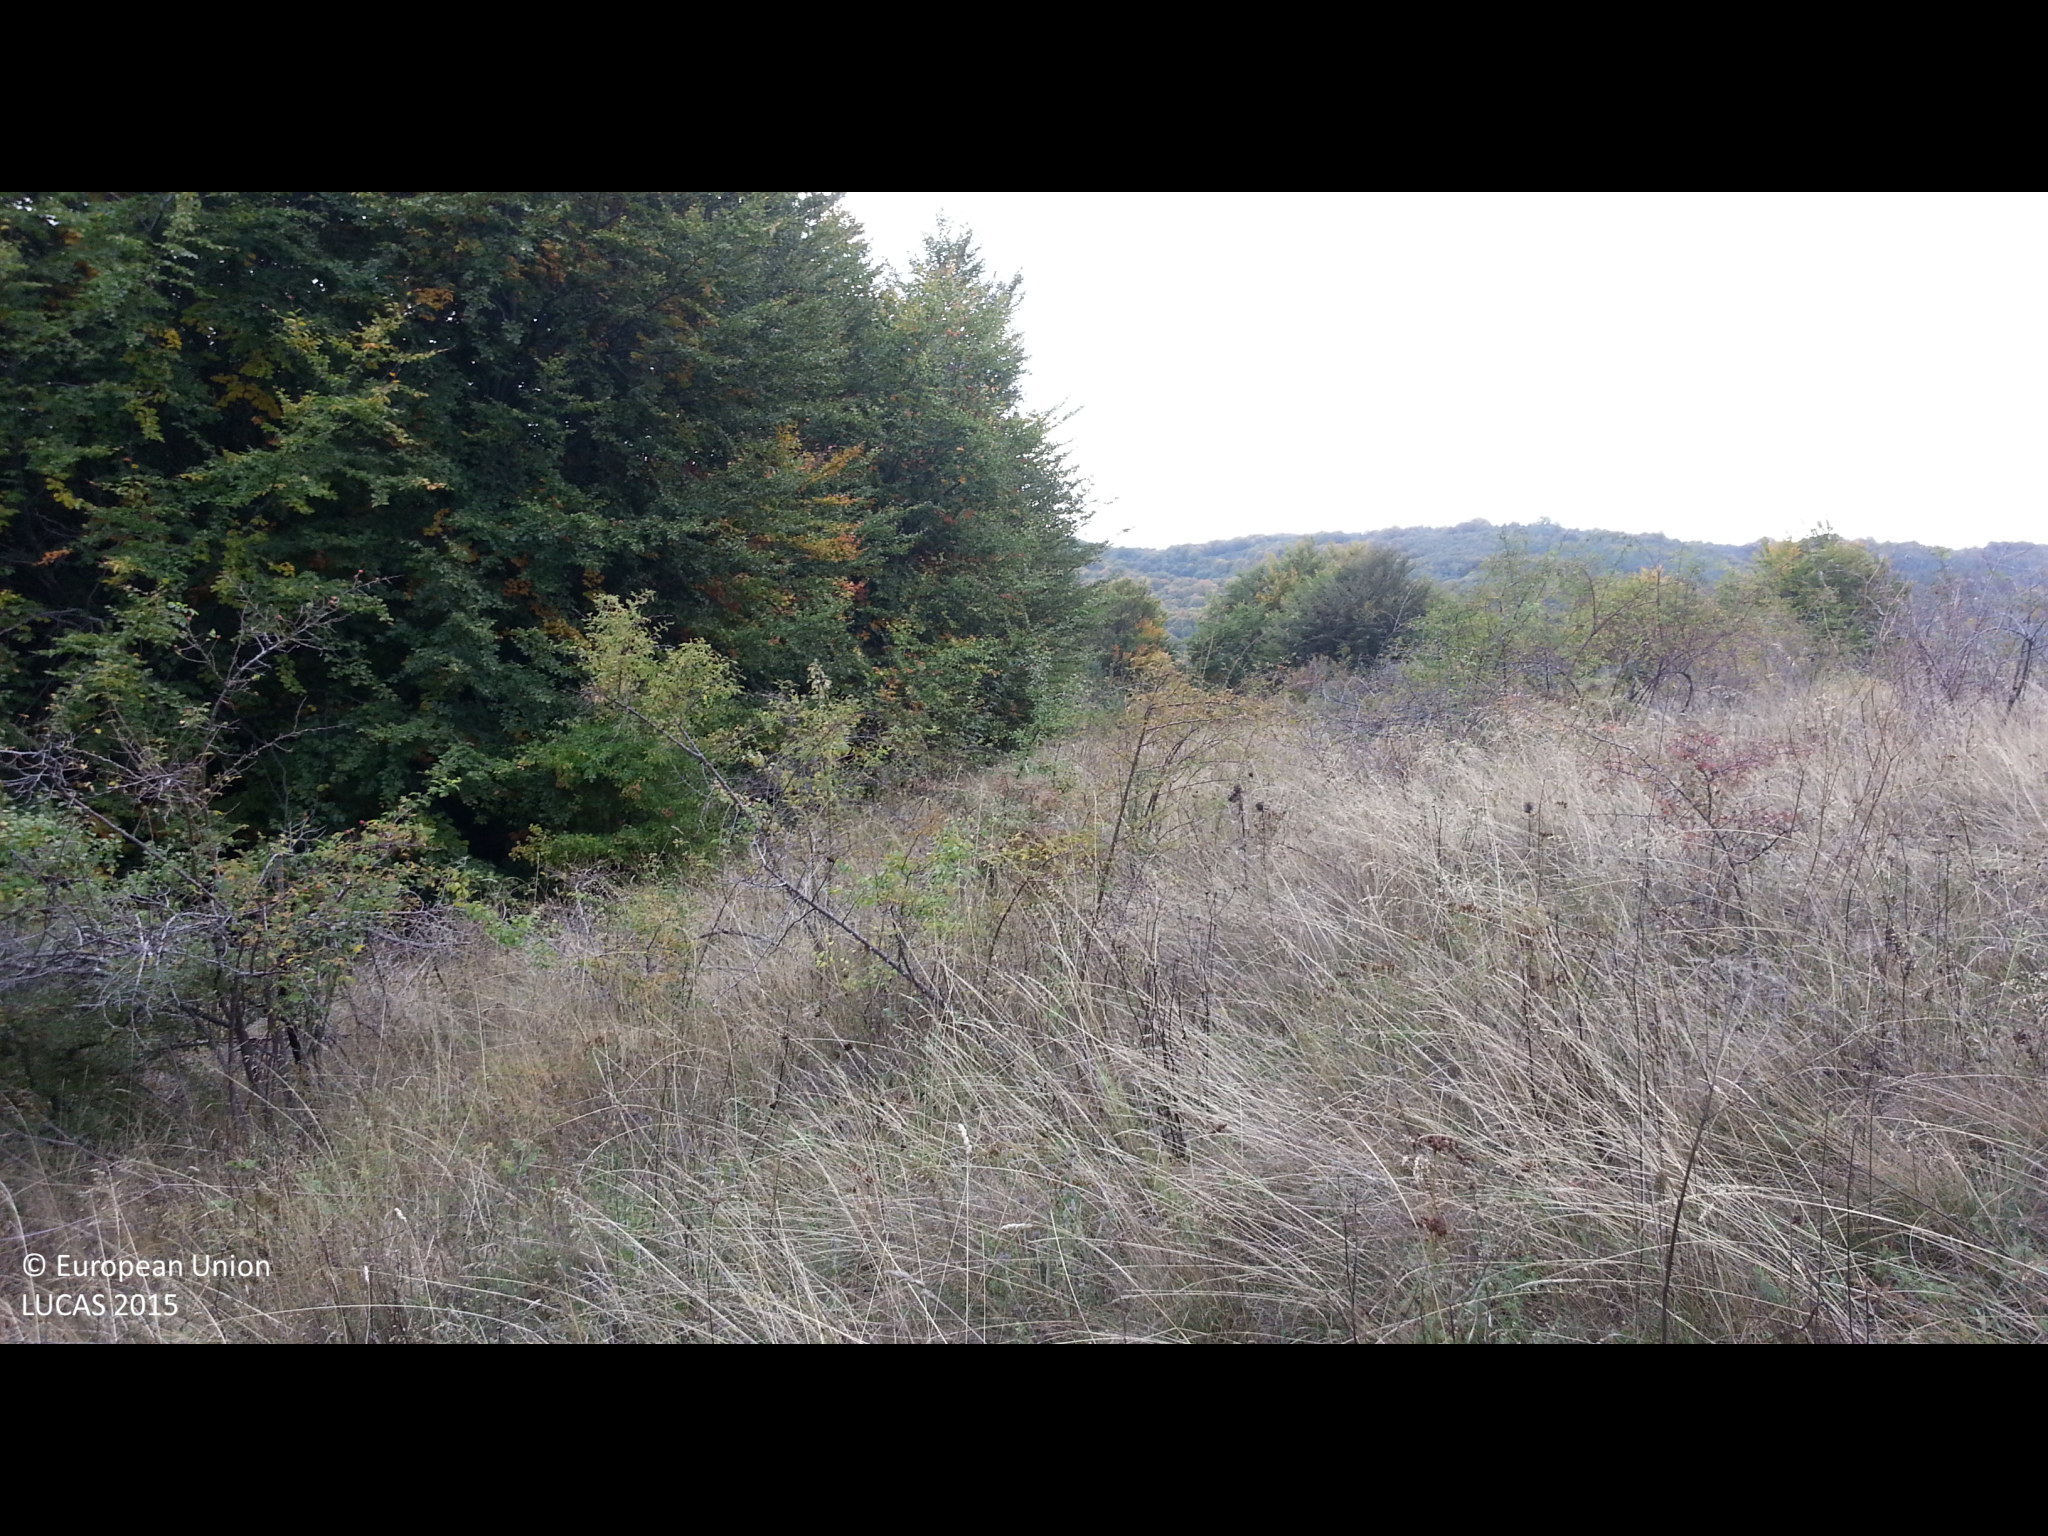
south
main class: Grassland
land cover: Grassland with sparse tree/shrub cover
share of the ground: > 75 %
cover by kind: herbaceous plants 85 %, shrubs 10 %, broadleaved forest trees 5 %
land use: Agriculture (excluding fallow land and kitchen gardens)
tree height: < 5 m
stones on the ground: < 10 %
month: October
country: BG
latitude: 42.6607
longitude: 22.5034
